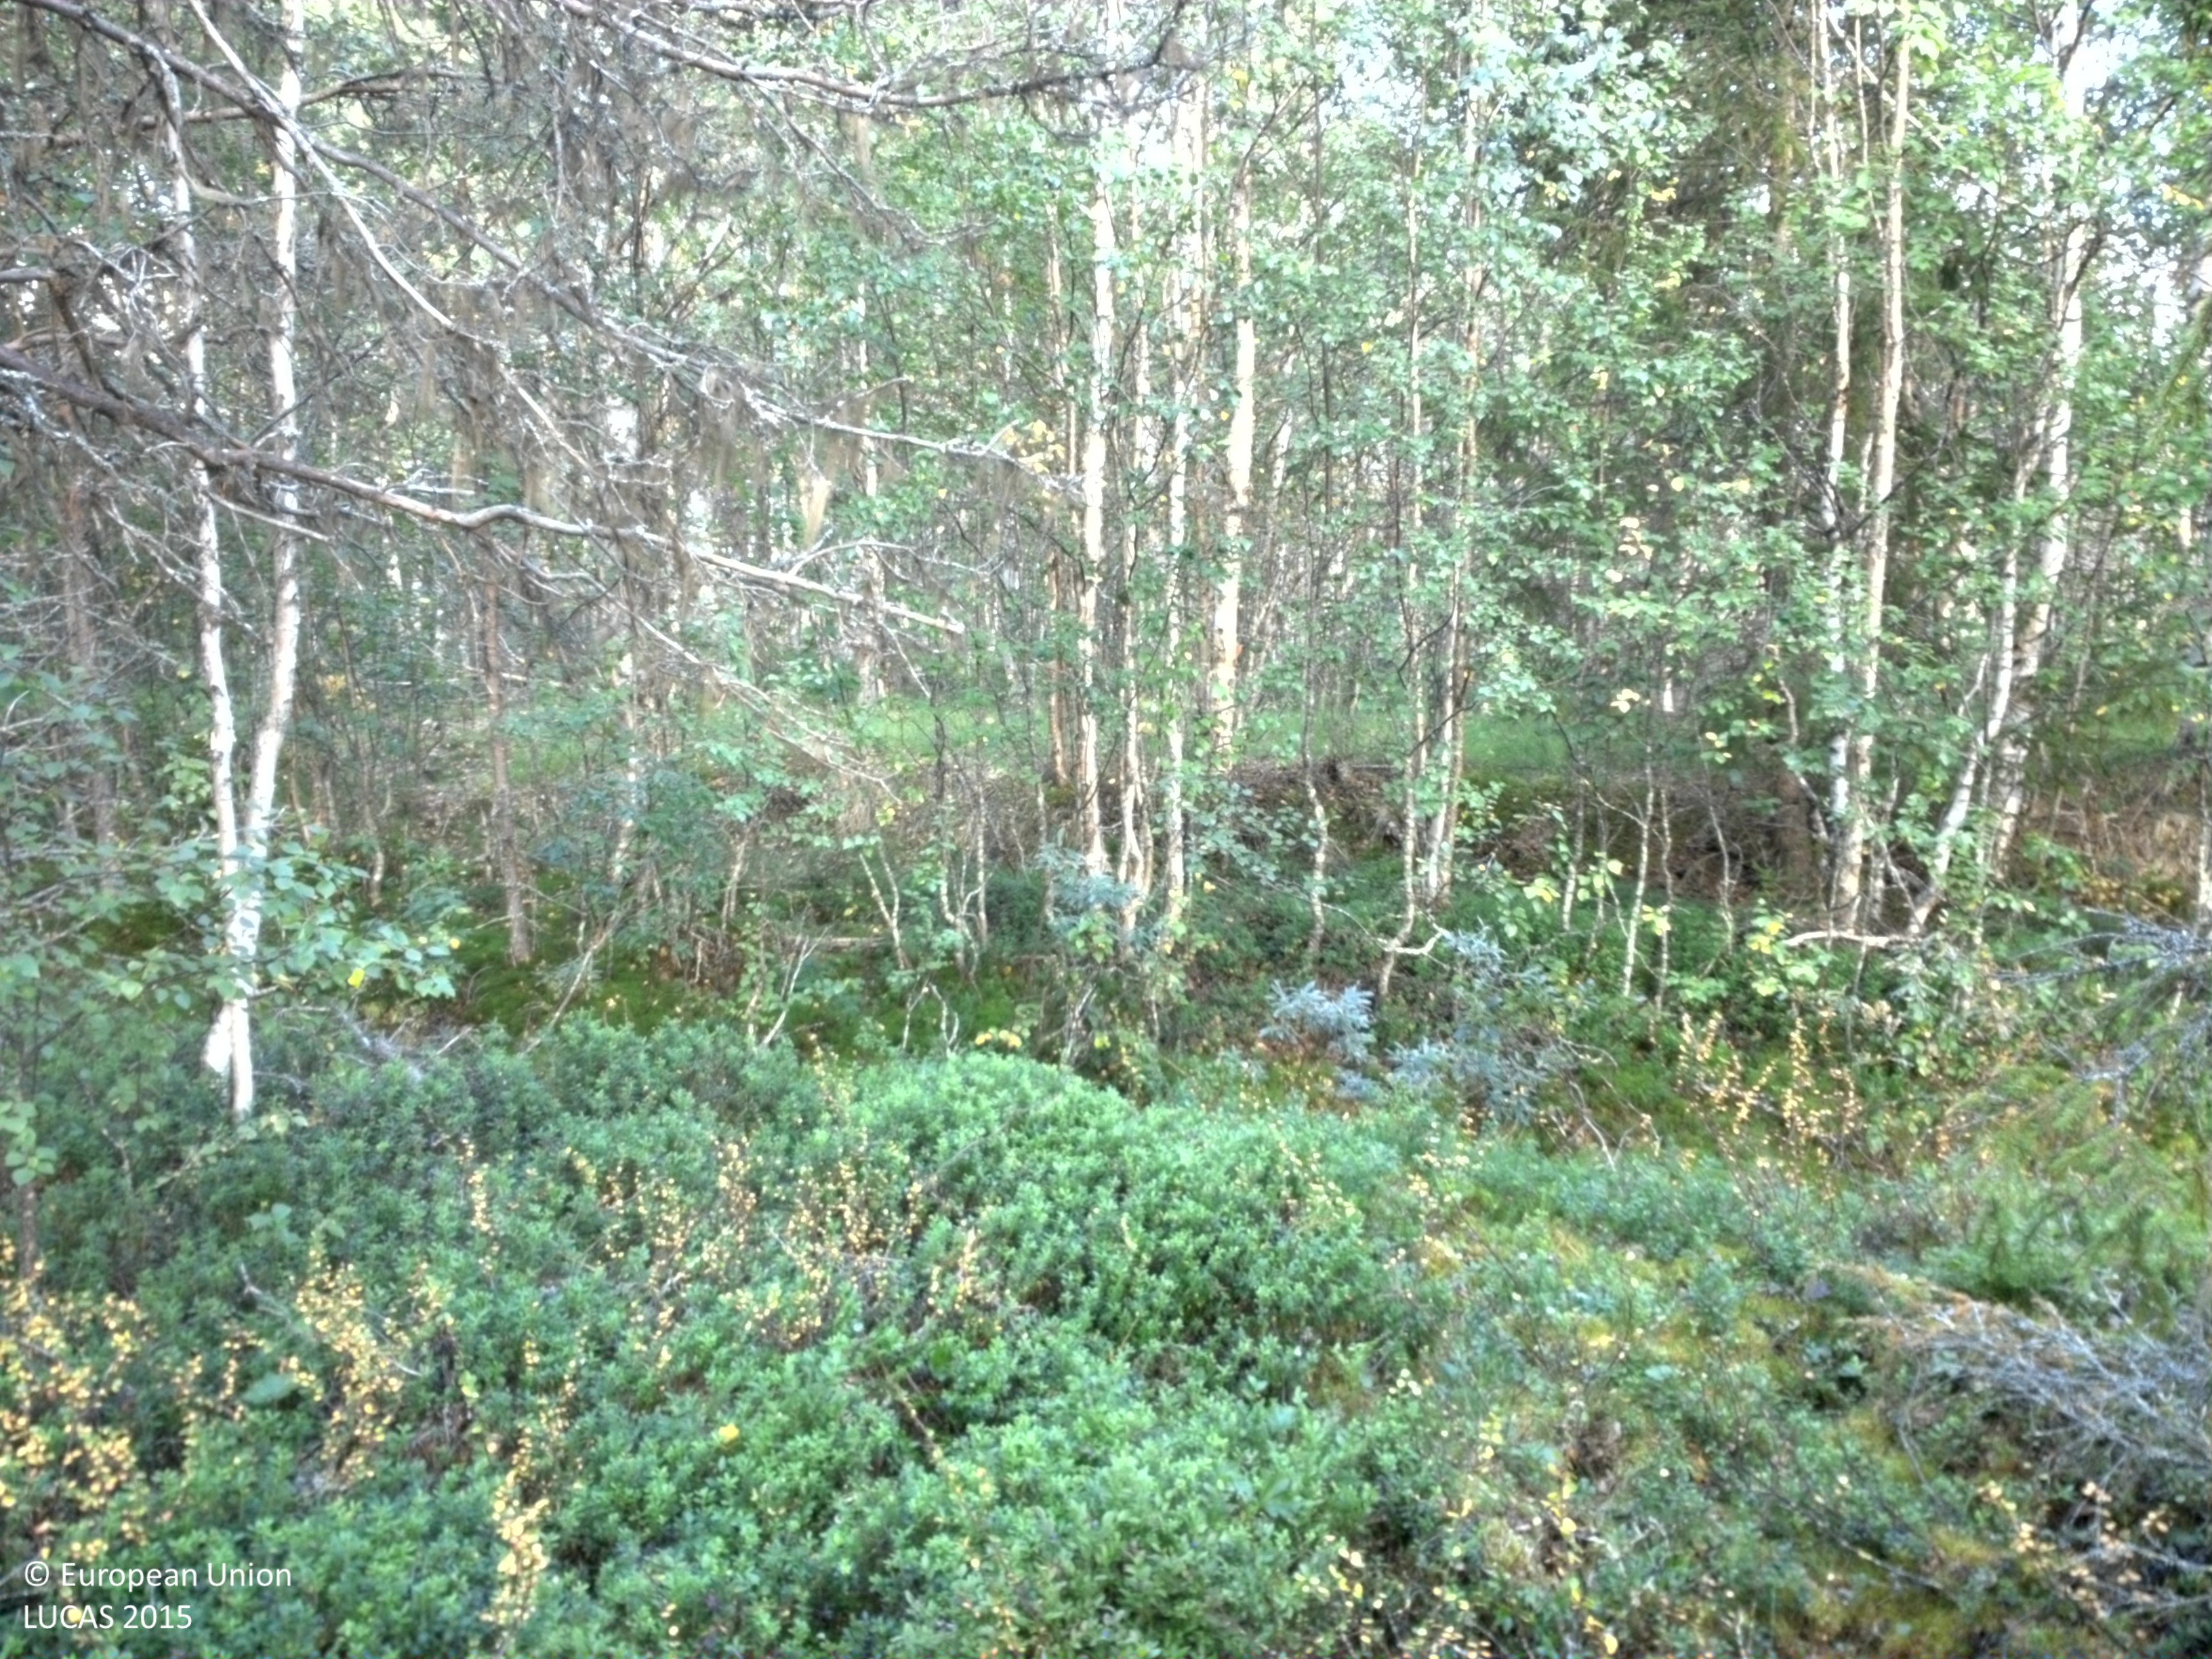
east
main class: Woodland
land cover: Pine dominated mixed woodland
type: boreal forest
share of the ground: 25 - 50 %
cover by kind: shrubs 45 %, coniferous forest trees 30 %, broadleaved forest trees 10 %, lichens and mosses 10 %, herbaceous plants 5 %
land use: Forestry
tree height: > 5 m
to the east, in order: Pine dominated mixed woodland; Ditches and canals; Broadleaved woodland; Tracks; Broadleaved woodland; Ditches and canals; Pine dominated mixed woodland; Pine dominated coniferous woodland; Shrubland with sparse tree cover; Electric lines; Shrubland with sparse tree cover; Inland fresh water bodies; Shrubland with sparse tree cover; Peatbogs; Shrubland with sparse tree cover; Peatbogs; Ditches and canals
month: August
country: SE
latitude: 64.5773
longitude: 16.8356
